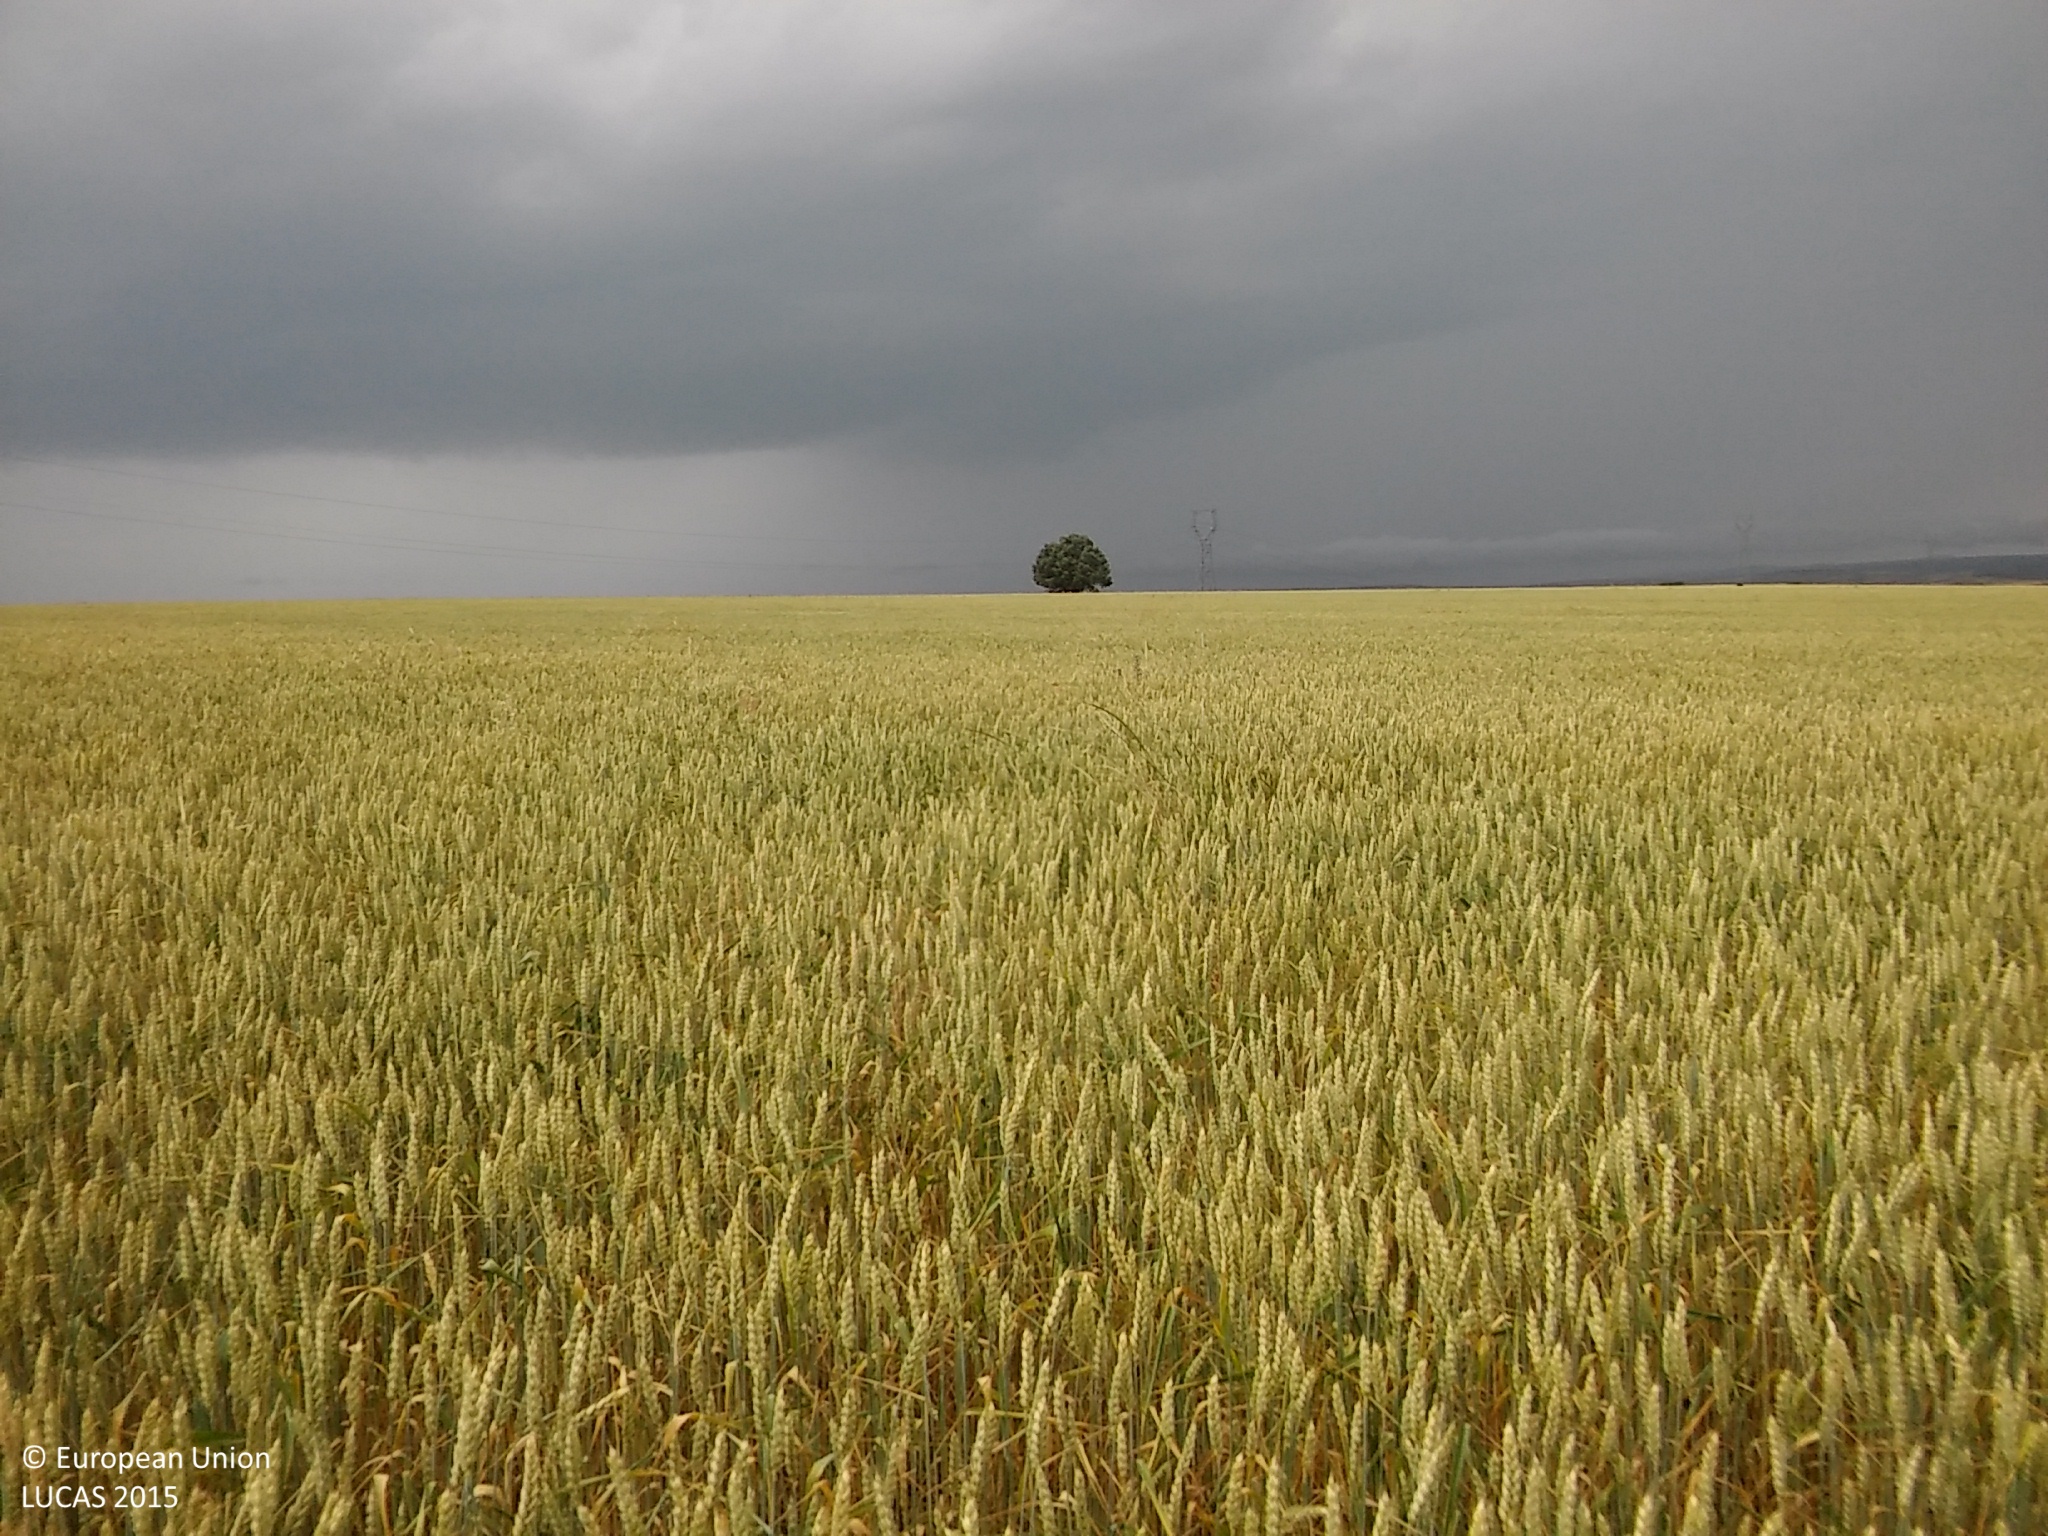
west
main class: Cropland
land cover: Common wheat
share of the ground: > 75 %
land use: Agriculture (excluding fallow land and kitchen gardens)
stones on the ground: 25 - 50 %
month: June
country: ES
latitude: 41.2475
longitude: -3.6632
